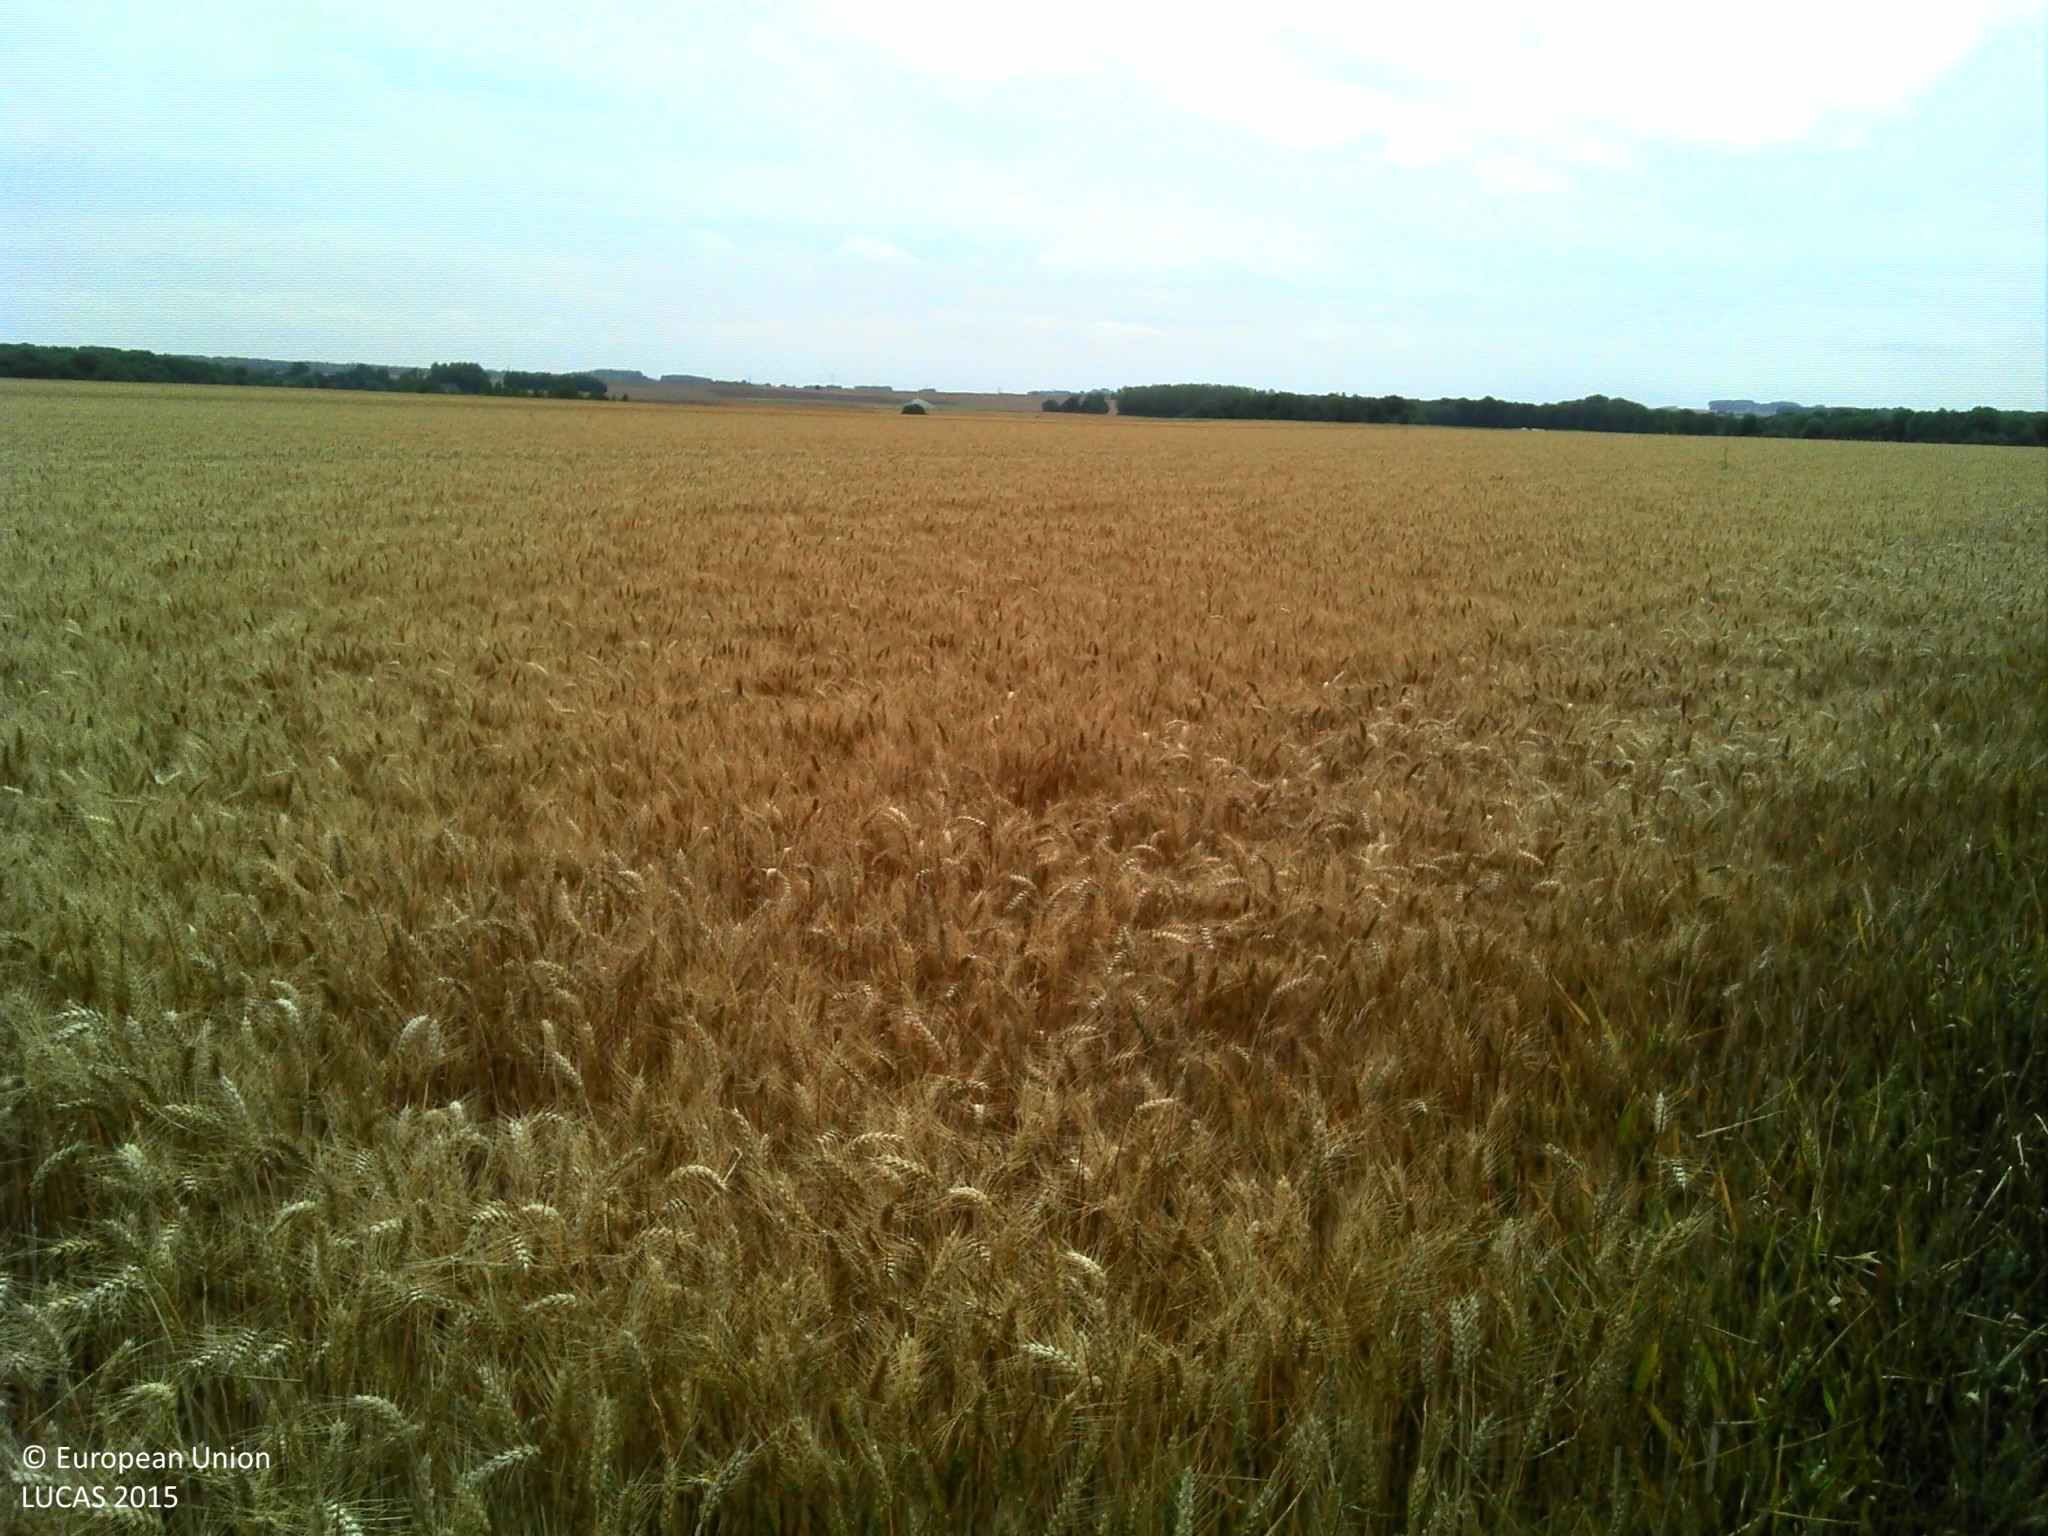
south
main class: Cropland
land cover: Maize
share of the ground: > 75 %
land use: Agriculture (excluding fallow land and kitchen gardens)
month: July
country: FR
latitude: 50.1198
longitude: 2.5332
